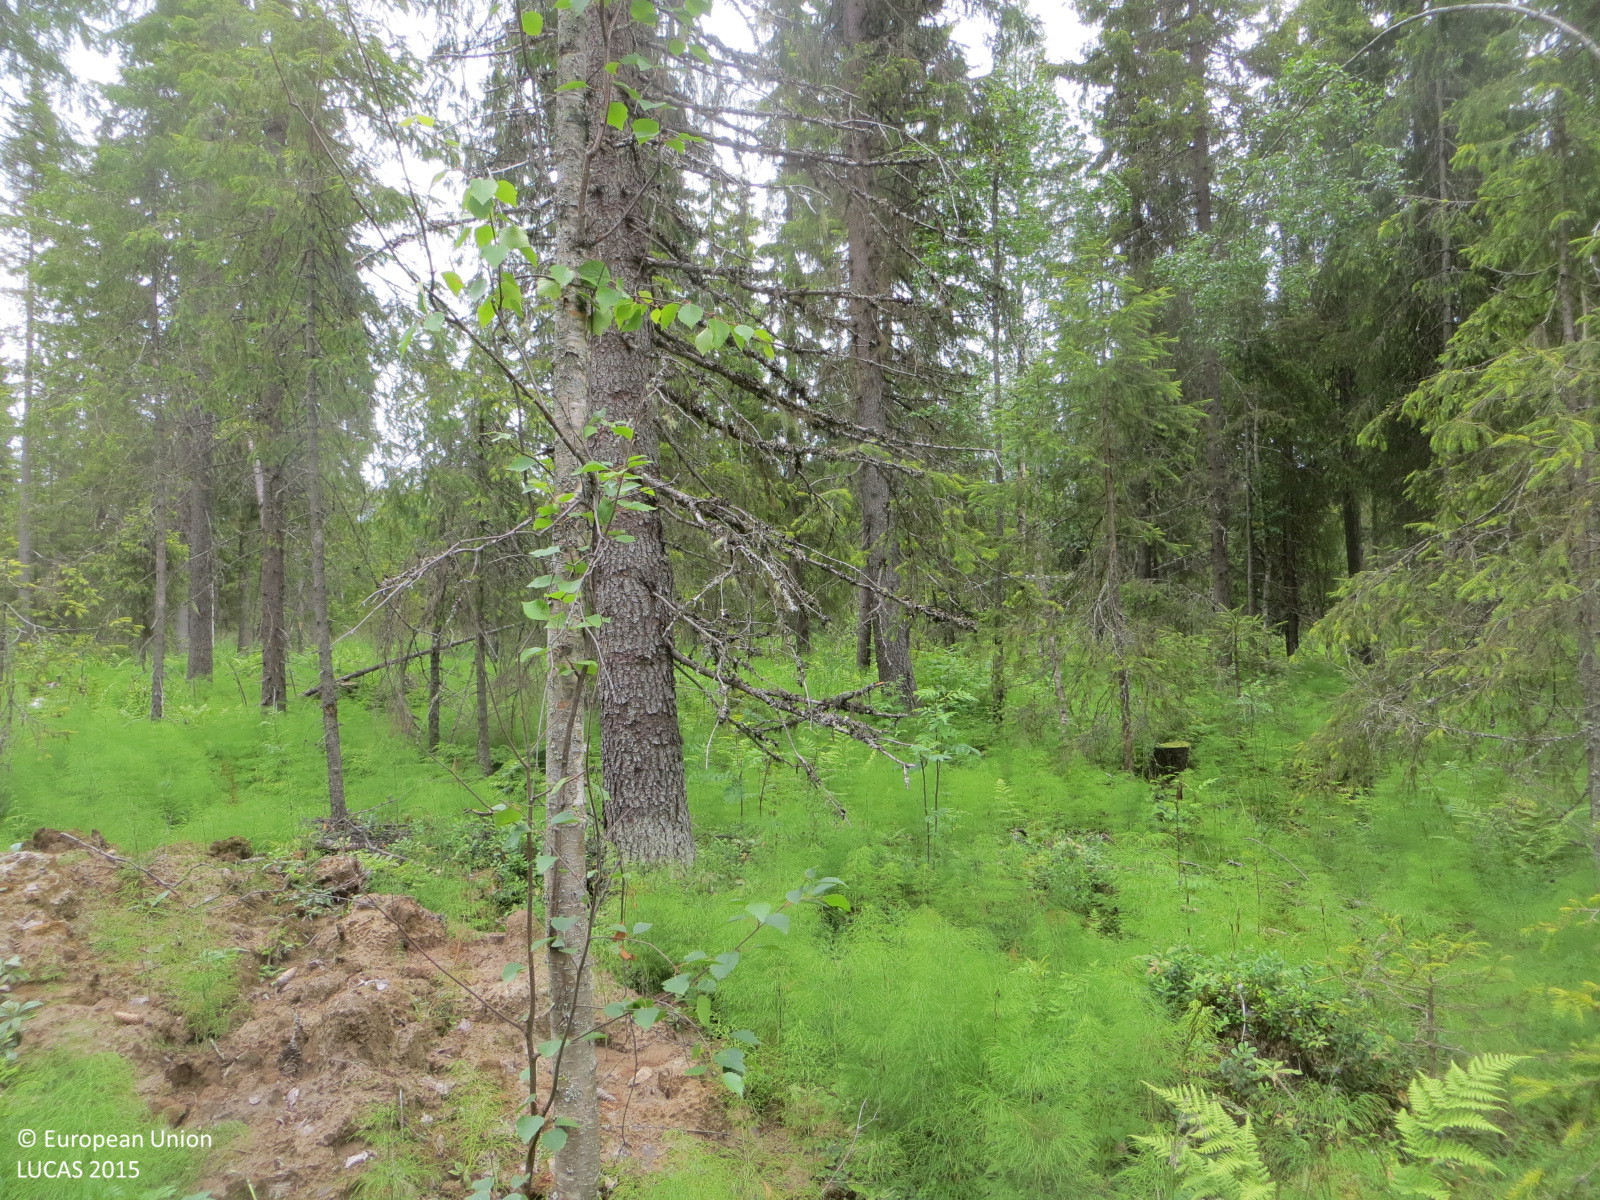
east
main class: Woodland
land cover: Spruce dominated coniferous woodland
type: boreal forest
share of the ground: 50 - 75 %
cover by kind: coniferous forest trees 60 %, shrubs 35 %, broadleaved forest trees 5 %
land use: Forestry
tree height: > 5 m
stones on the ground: < 10 %
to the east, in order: Spruce dominated coniferous woodland; Ditches and canals; Abandoned hedges; Tracks; Abandoned hedges; Ditches and canals; Spruce dominated mixed woodland; Ditches and canals; Spruce dominated mixed woodland; Other mixed woodland
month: July
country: FI
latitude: 66.1555
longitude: 23.9393
